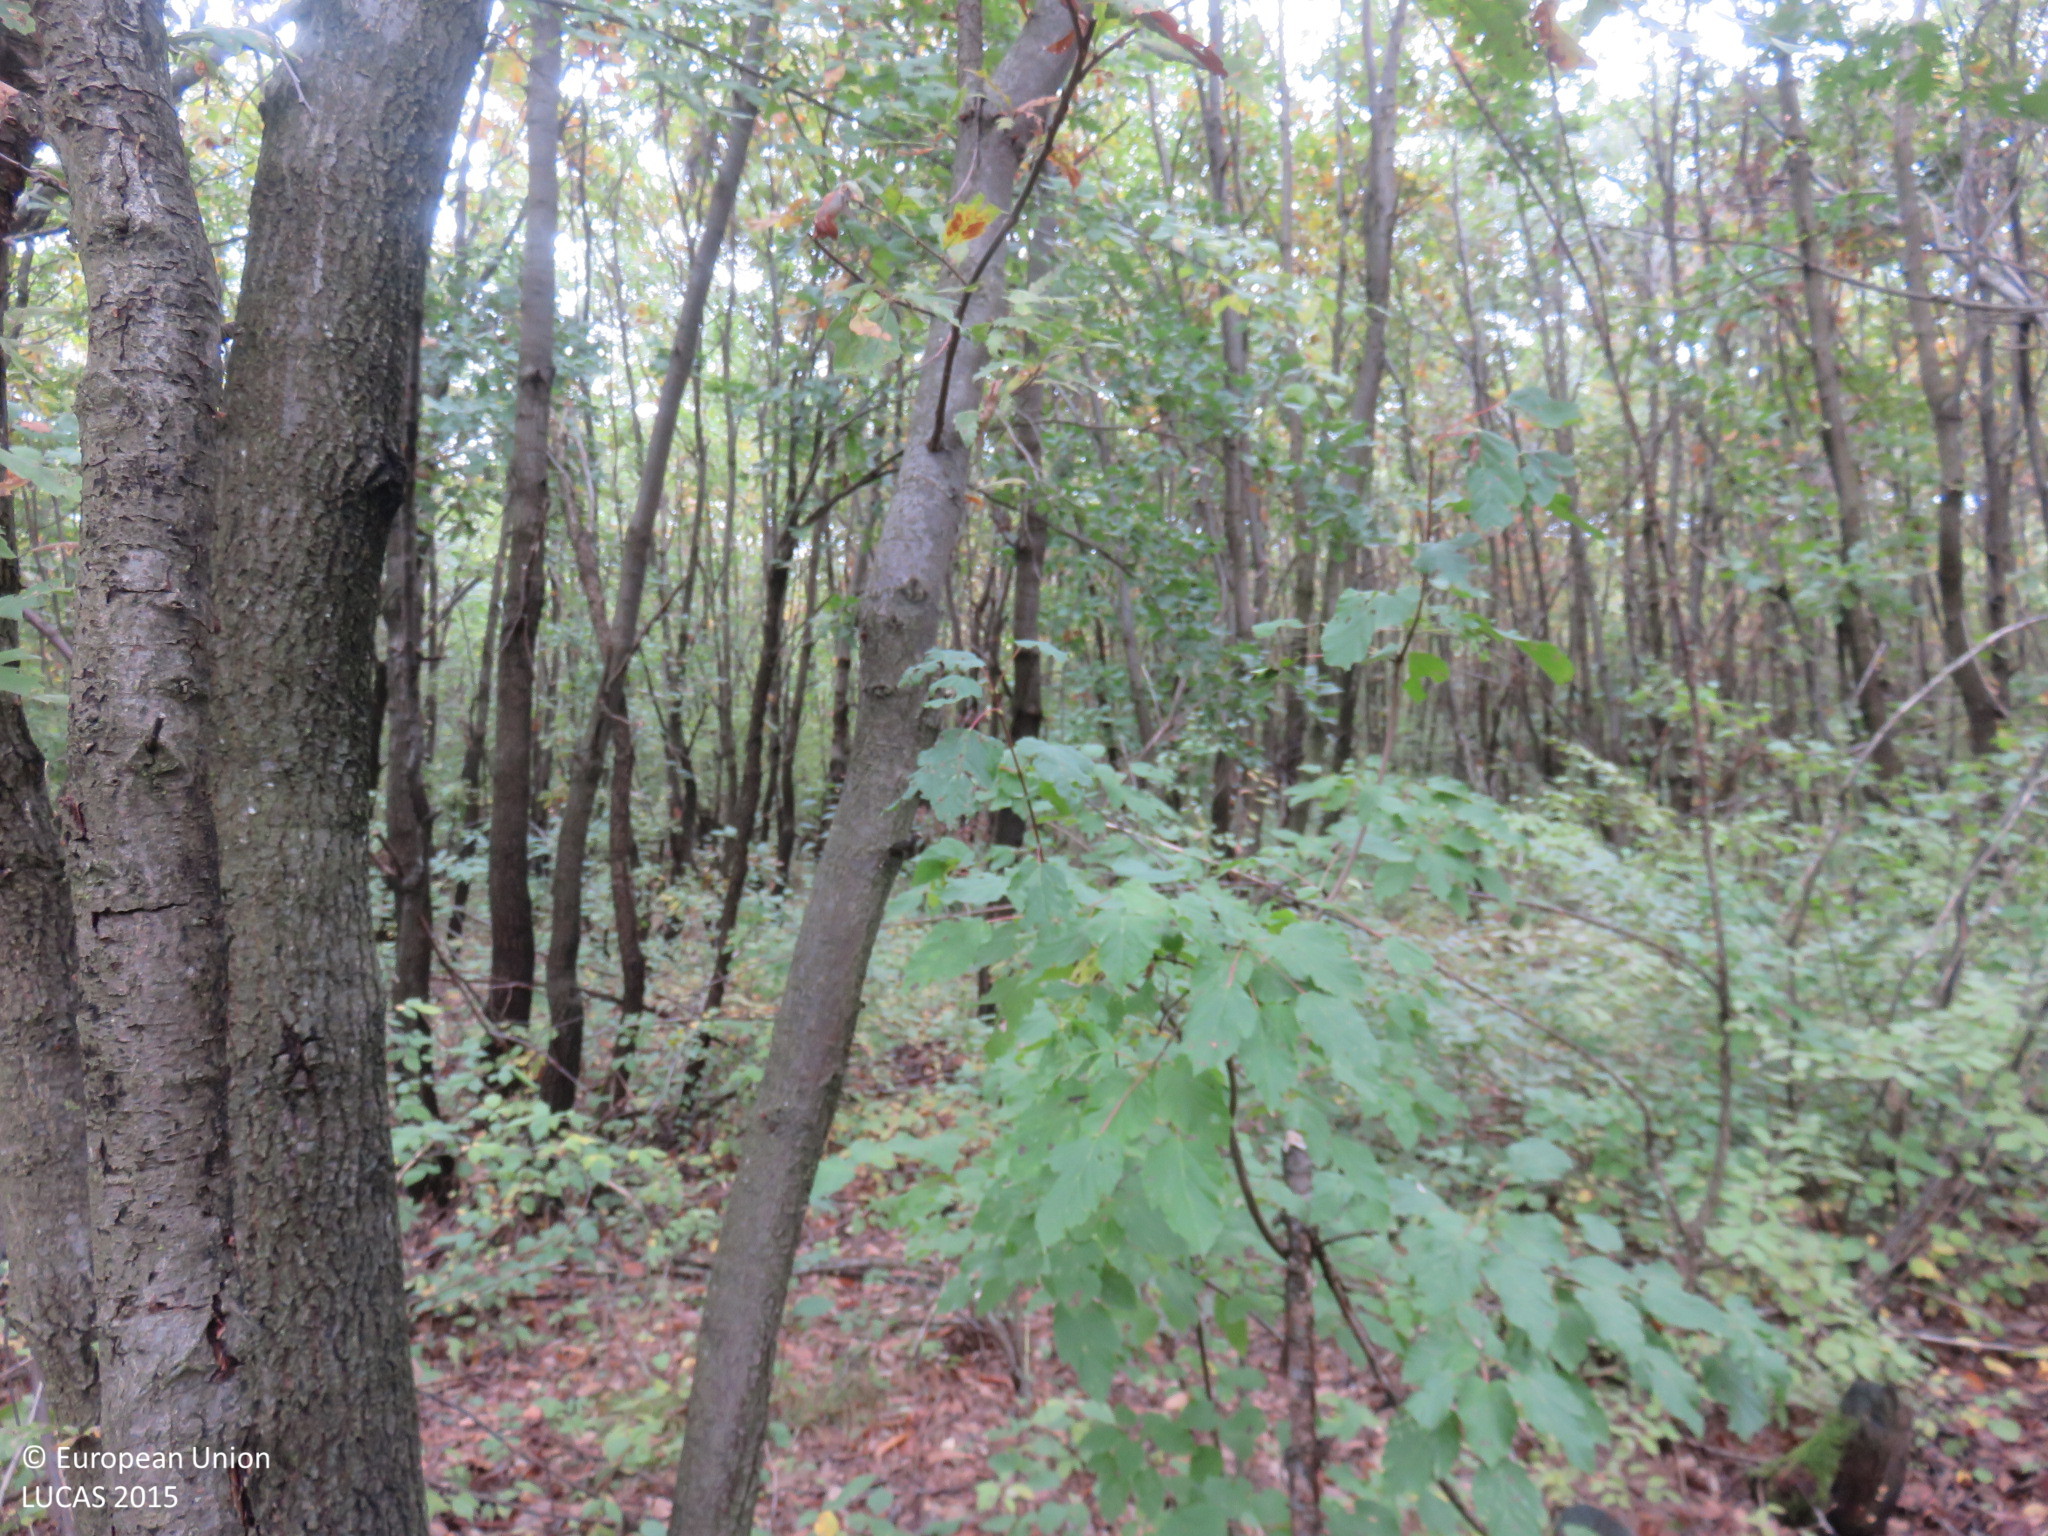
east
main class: Woodland
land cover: Broadleaved woodland
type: mesophytic deciduous forest
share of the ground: > 75 %
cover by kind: broadleaved forest trees 100 %
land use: Forestry
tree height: > 5 m
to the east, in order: Broadleaved woodland
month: October
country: BG
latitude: 43.0919
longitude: 25.2187
